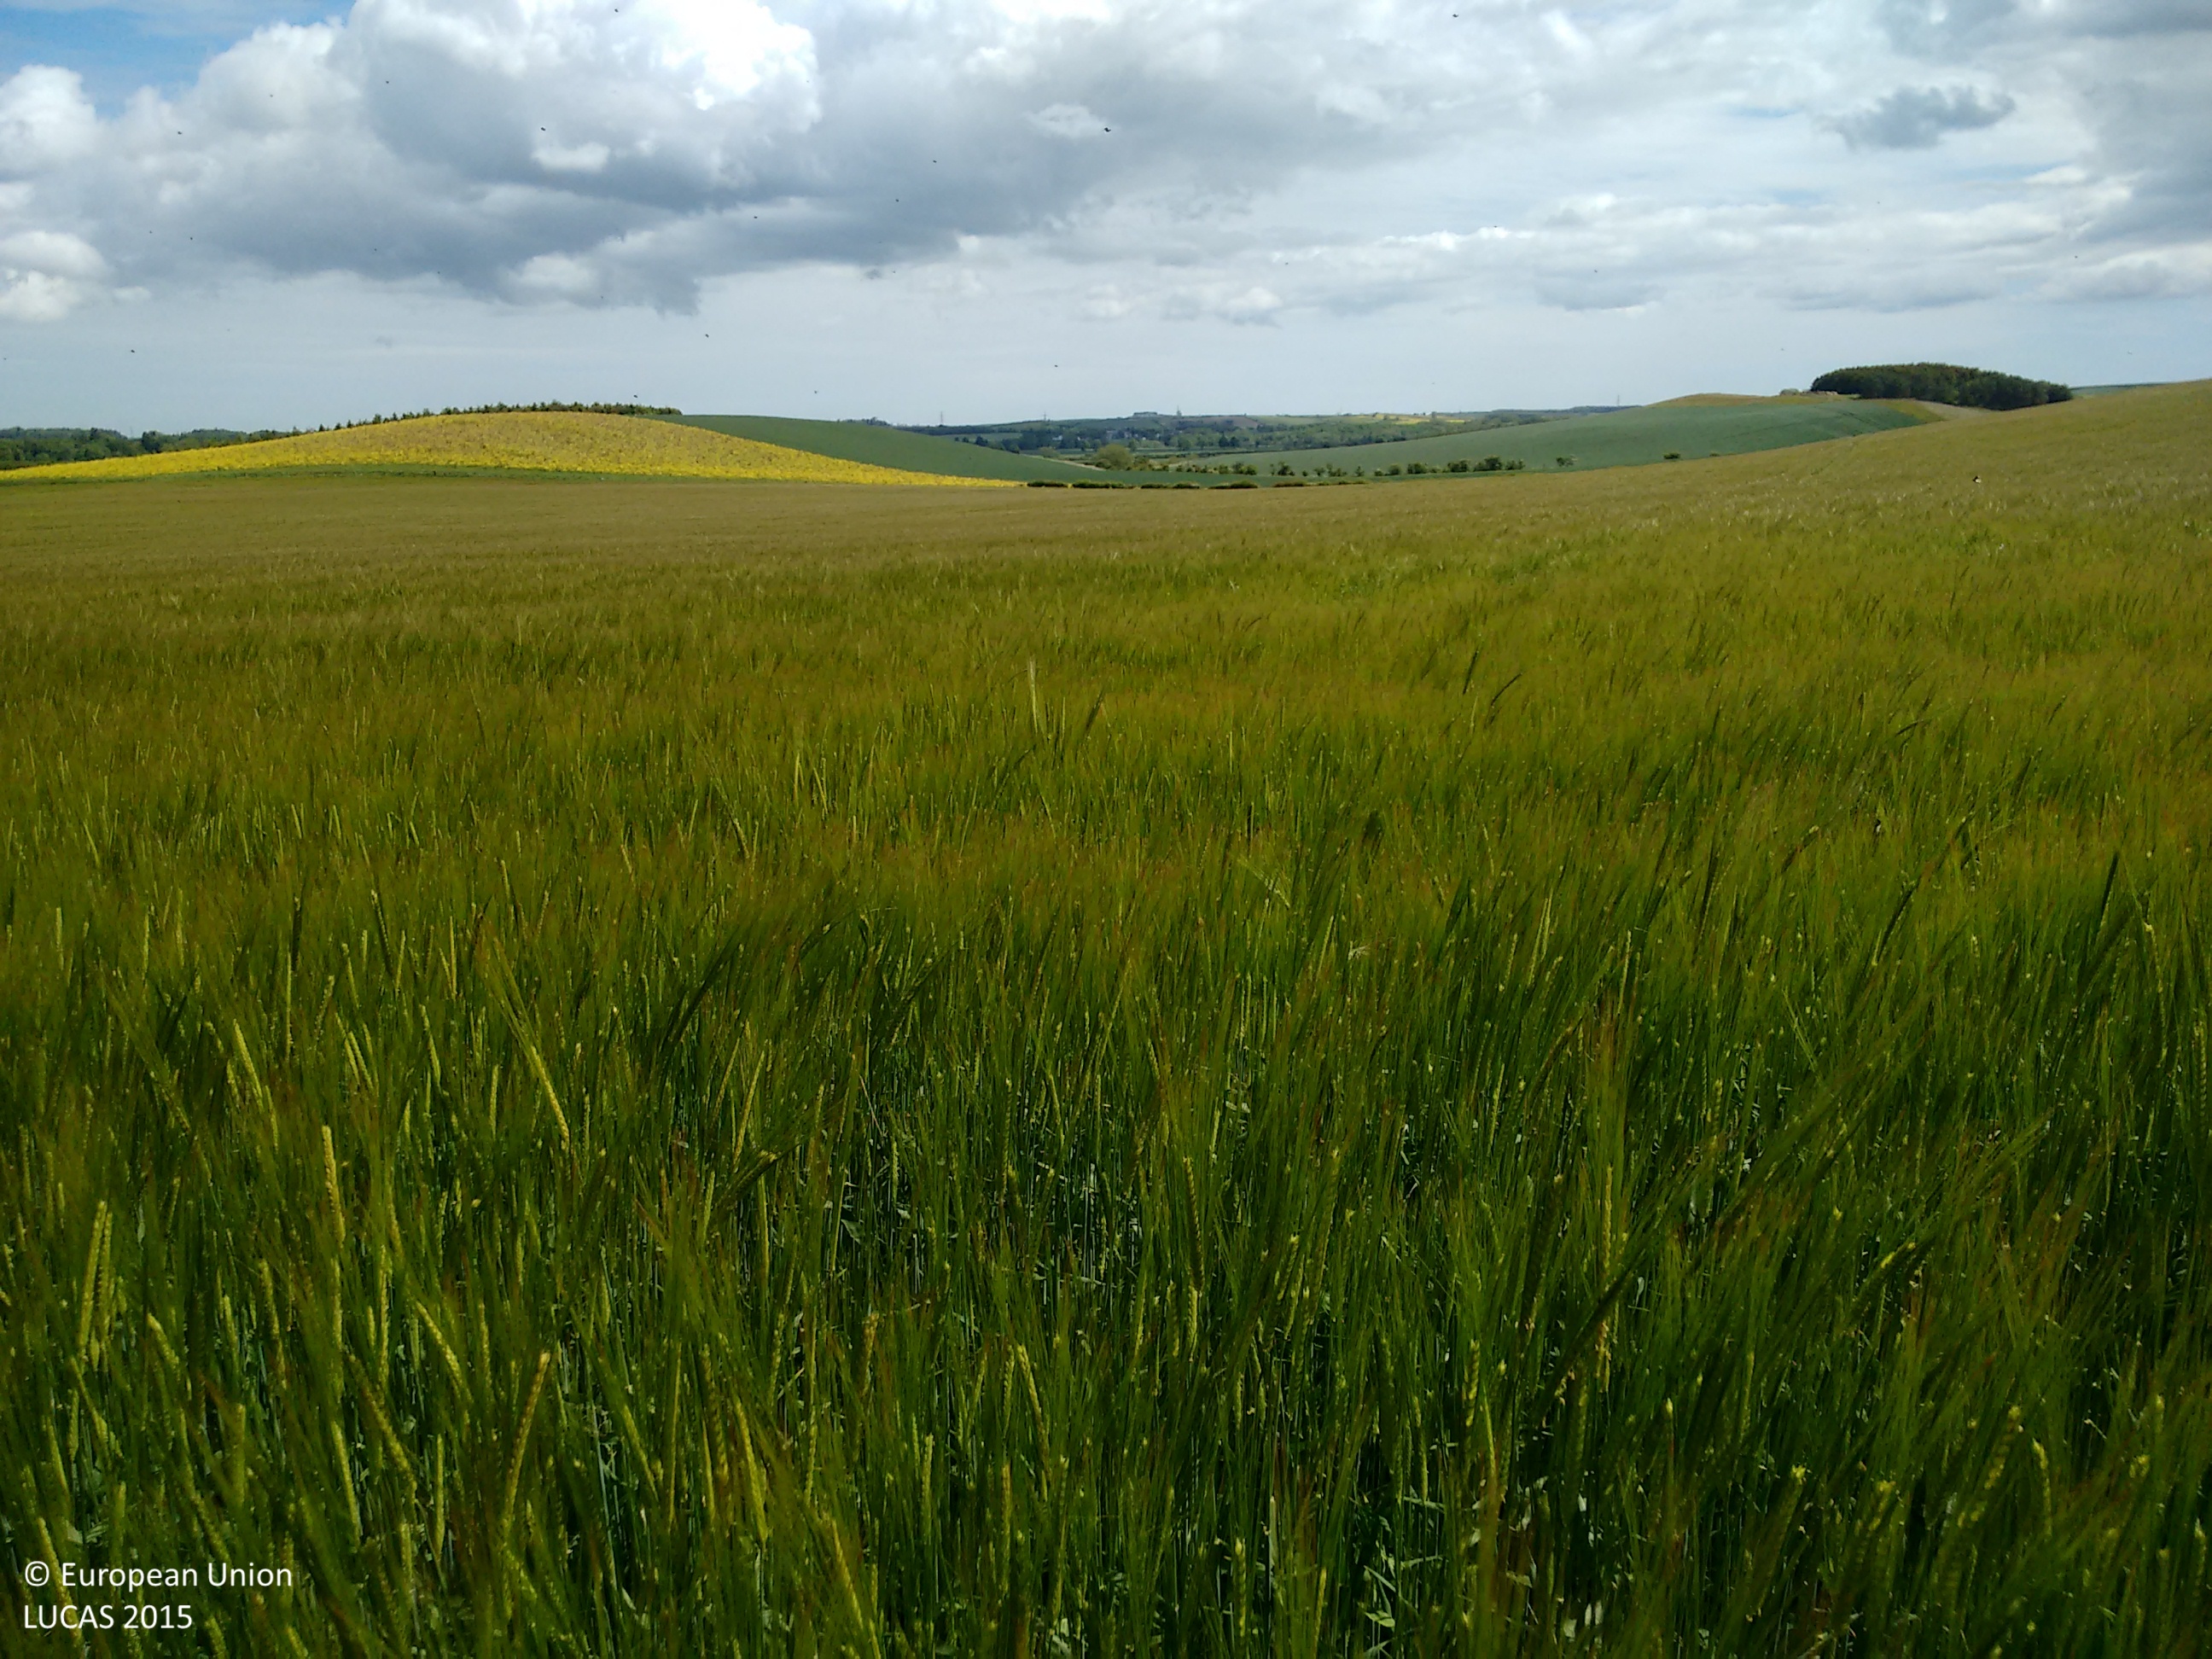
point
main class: Cropland
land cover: Barley
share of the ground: > 75 %
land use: Agriculture (excluding fallow land and kitchen gardens)
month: June
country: GB
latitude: 55.6324
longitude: -2.2717
